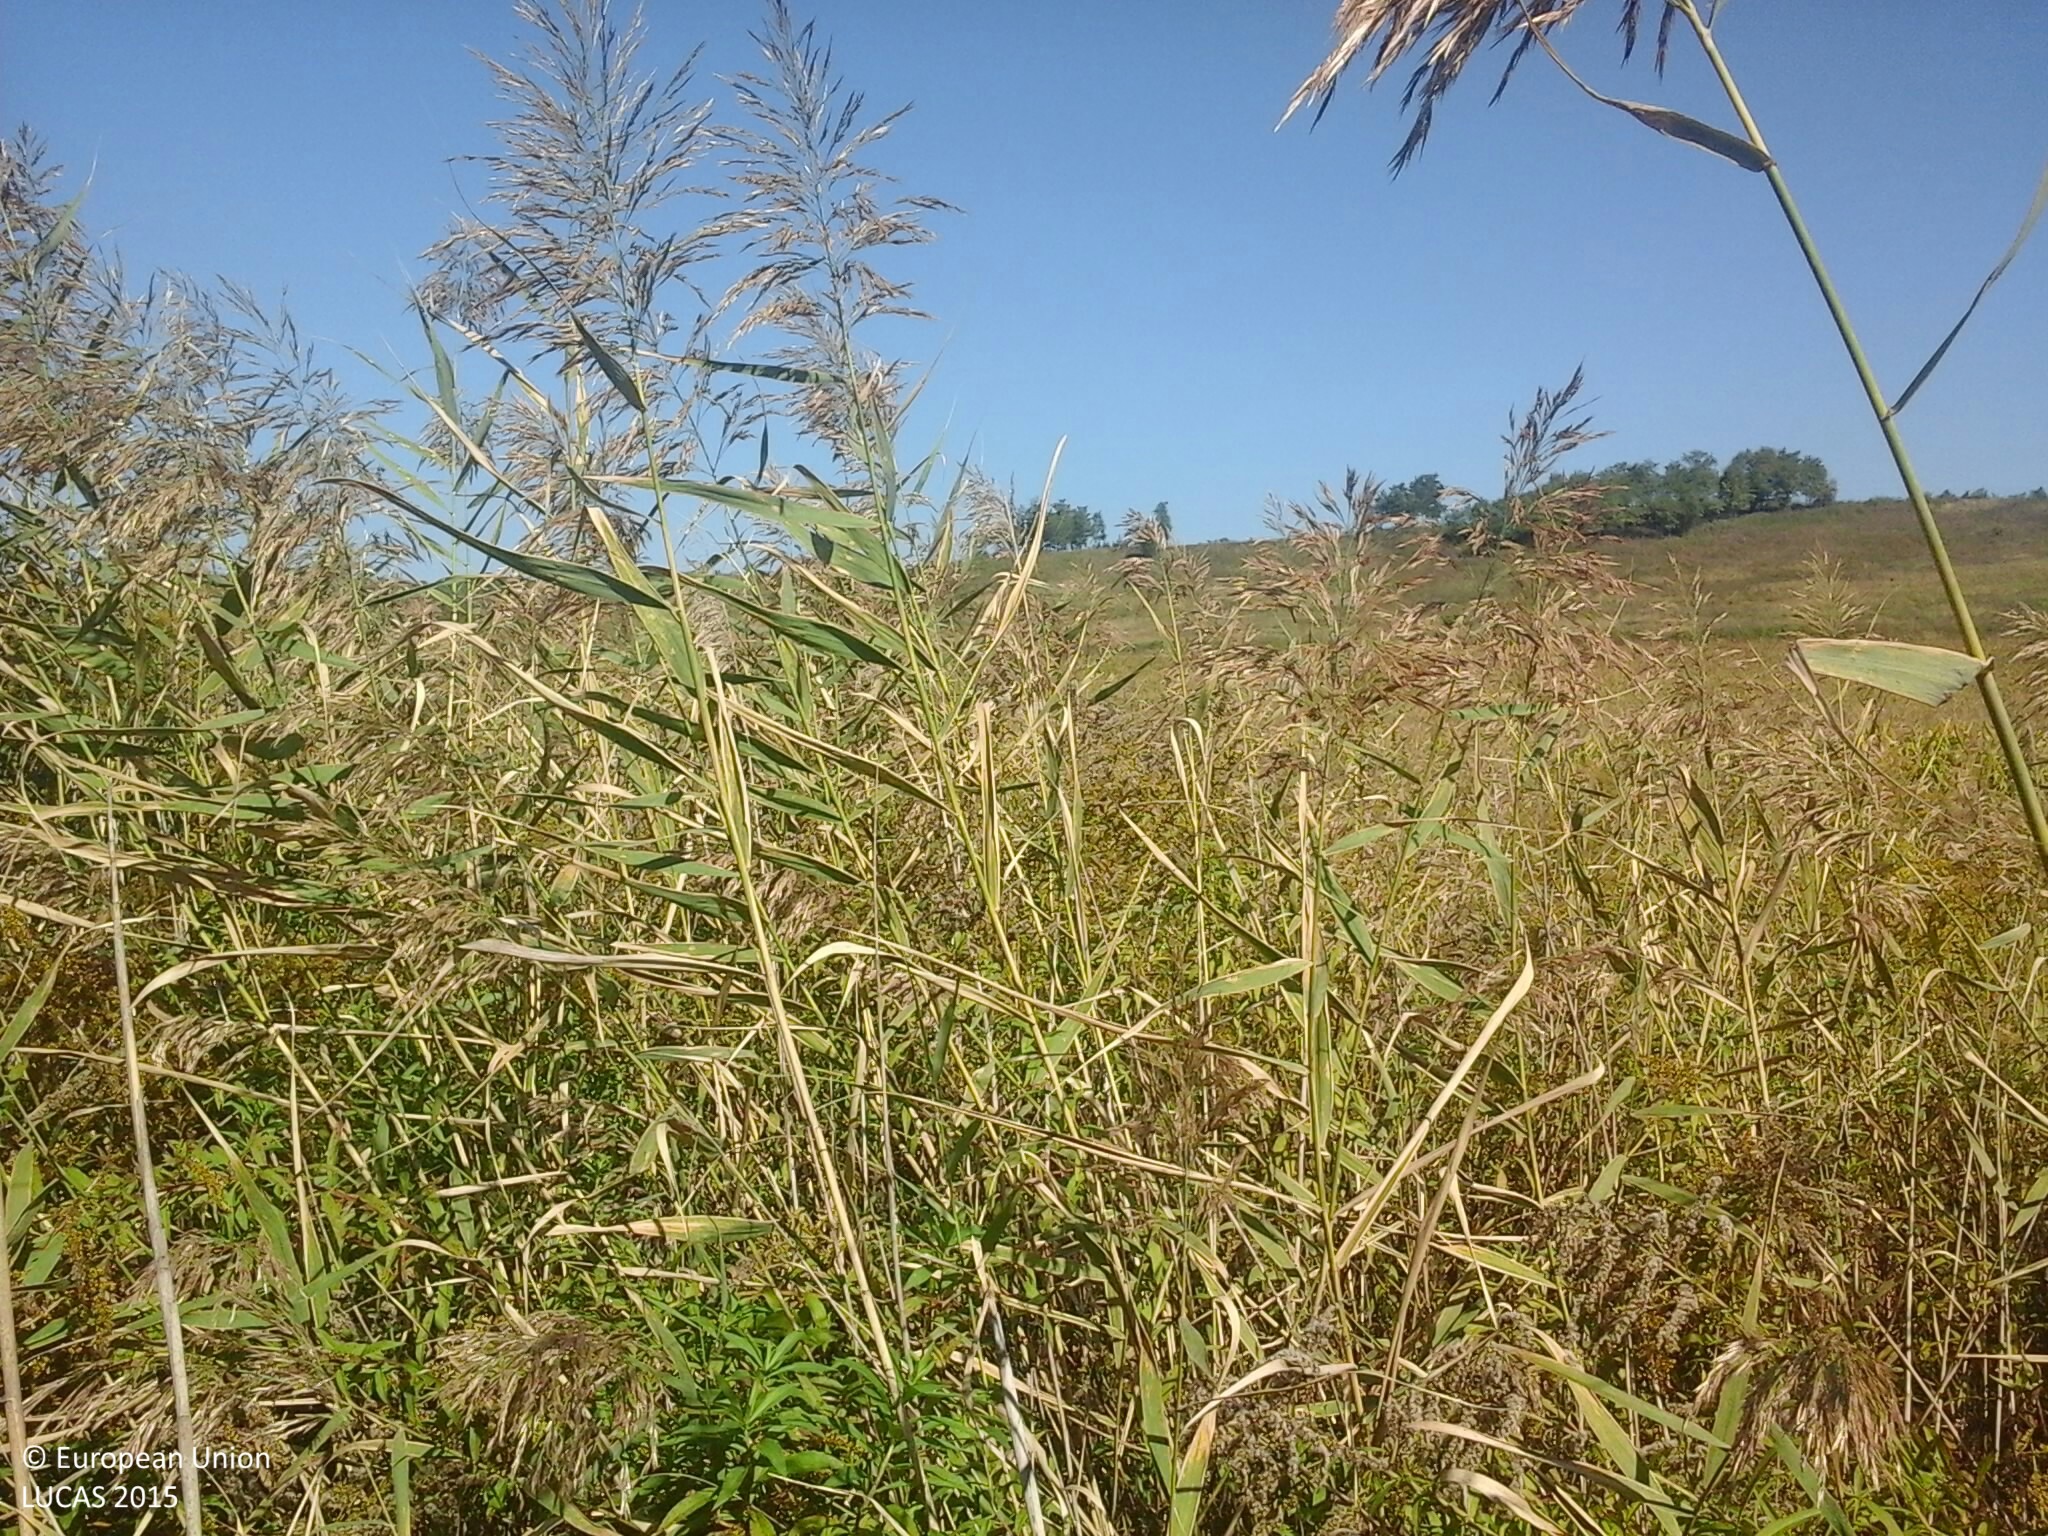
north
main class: Grassland
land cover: Spontaneously vegetated surfaces
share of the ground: > 75 %
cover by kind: herbaceous plants 100 %
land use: Abandoned areas
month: September
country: HU
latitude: 48.0451
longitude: 19.9407
